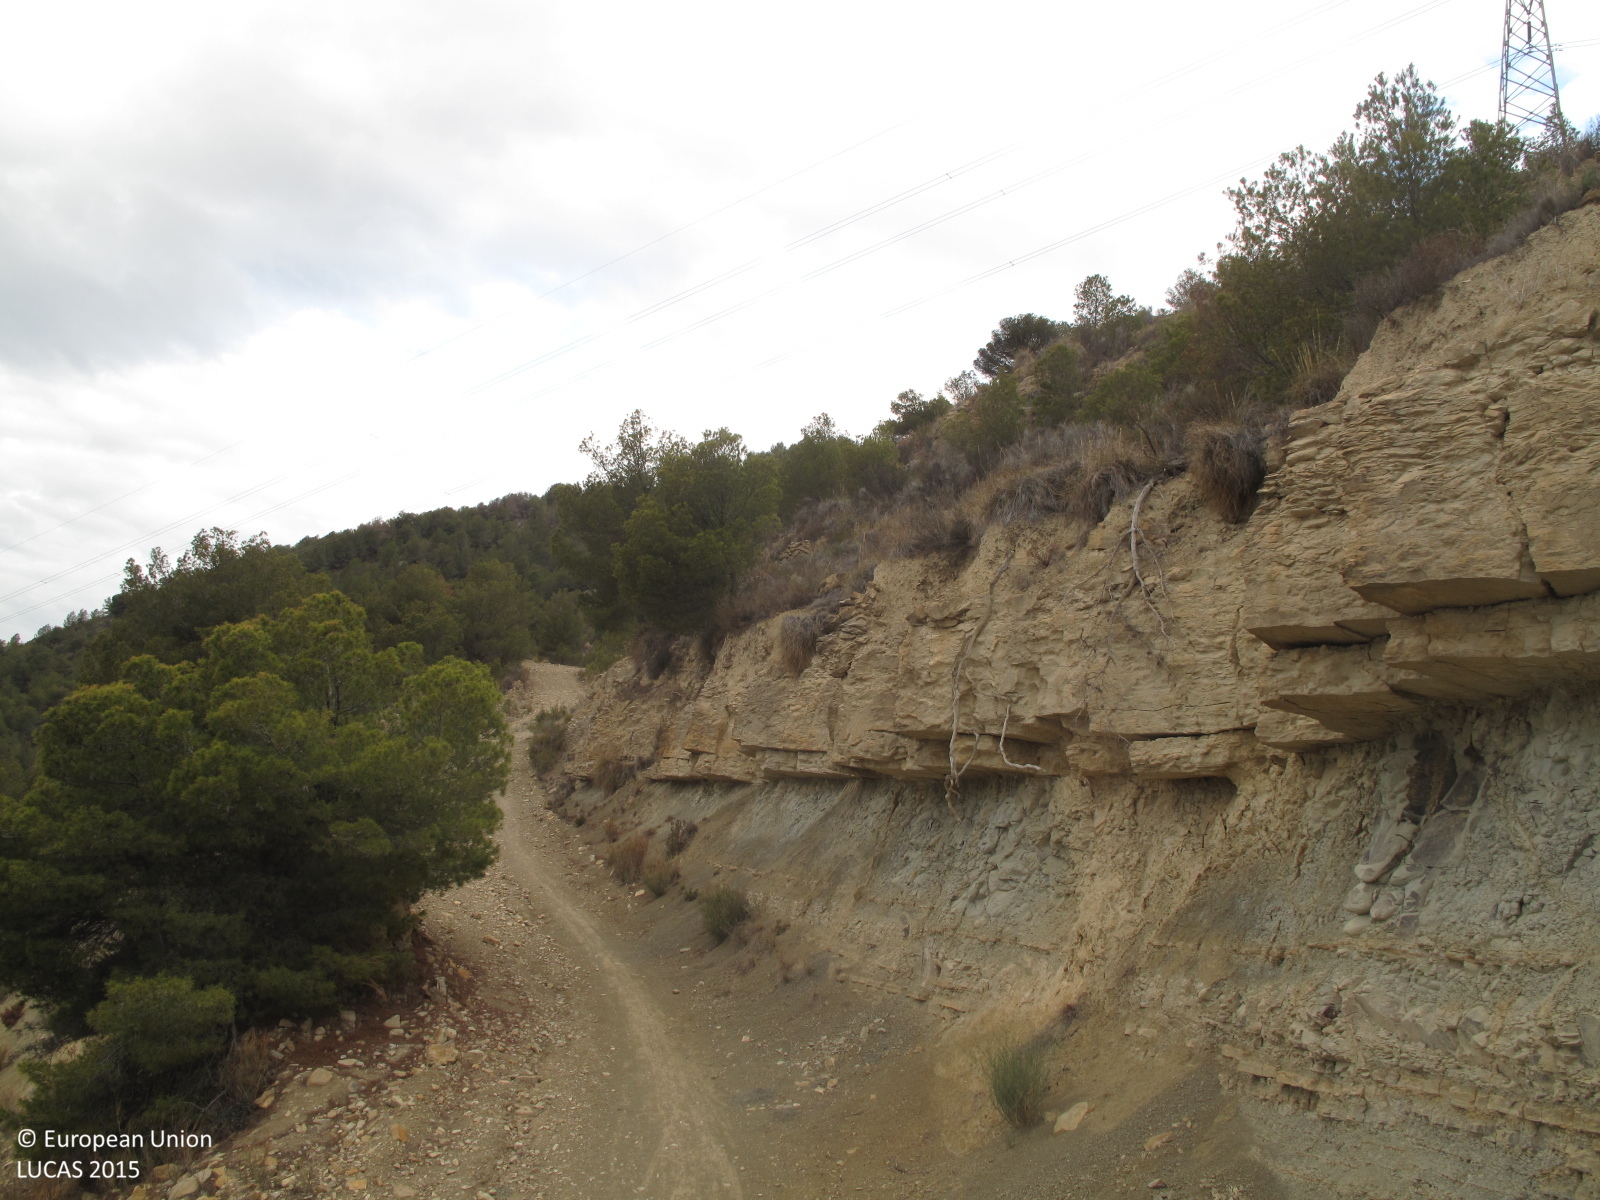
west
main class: Shrubland
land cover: Shrubland with sparse tree cover
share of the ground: 25 - 50 %
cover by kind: herbaceous plants 60 %, shrubs 25 %, consolidated bare surface 10 %, coniferous forest trees 5 %
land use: Semi-natural and natural areas not in use
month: May
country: ES
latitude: 38.6459
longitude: 0.0284
